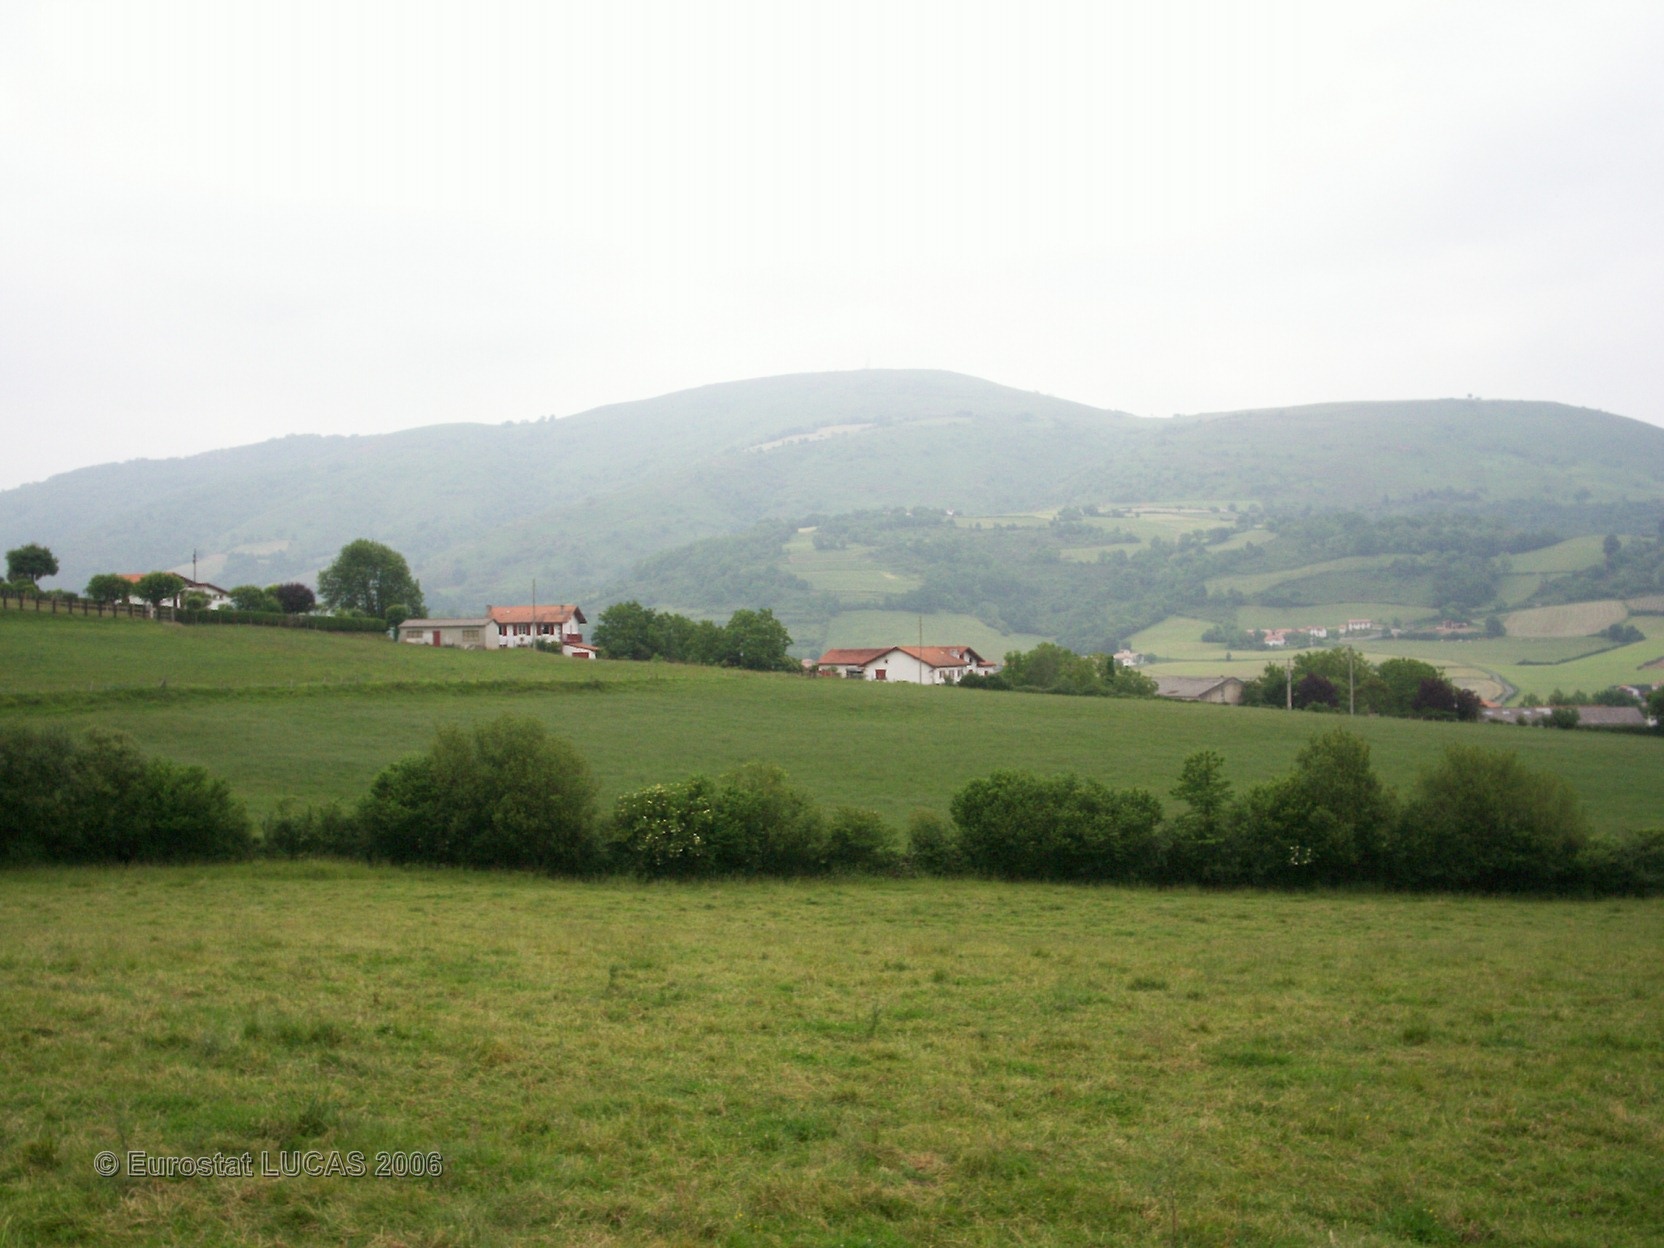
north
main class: Grassland
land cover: Grassland without tree/shrub cover
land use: Agriculture (excluding fallow land and kitchen gardens)
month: May
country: FR
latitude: 43.1677
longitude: -1.2933
